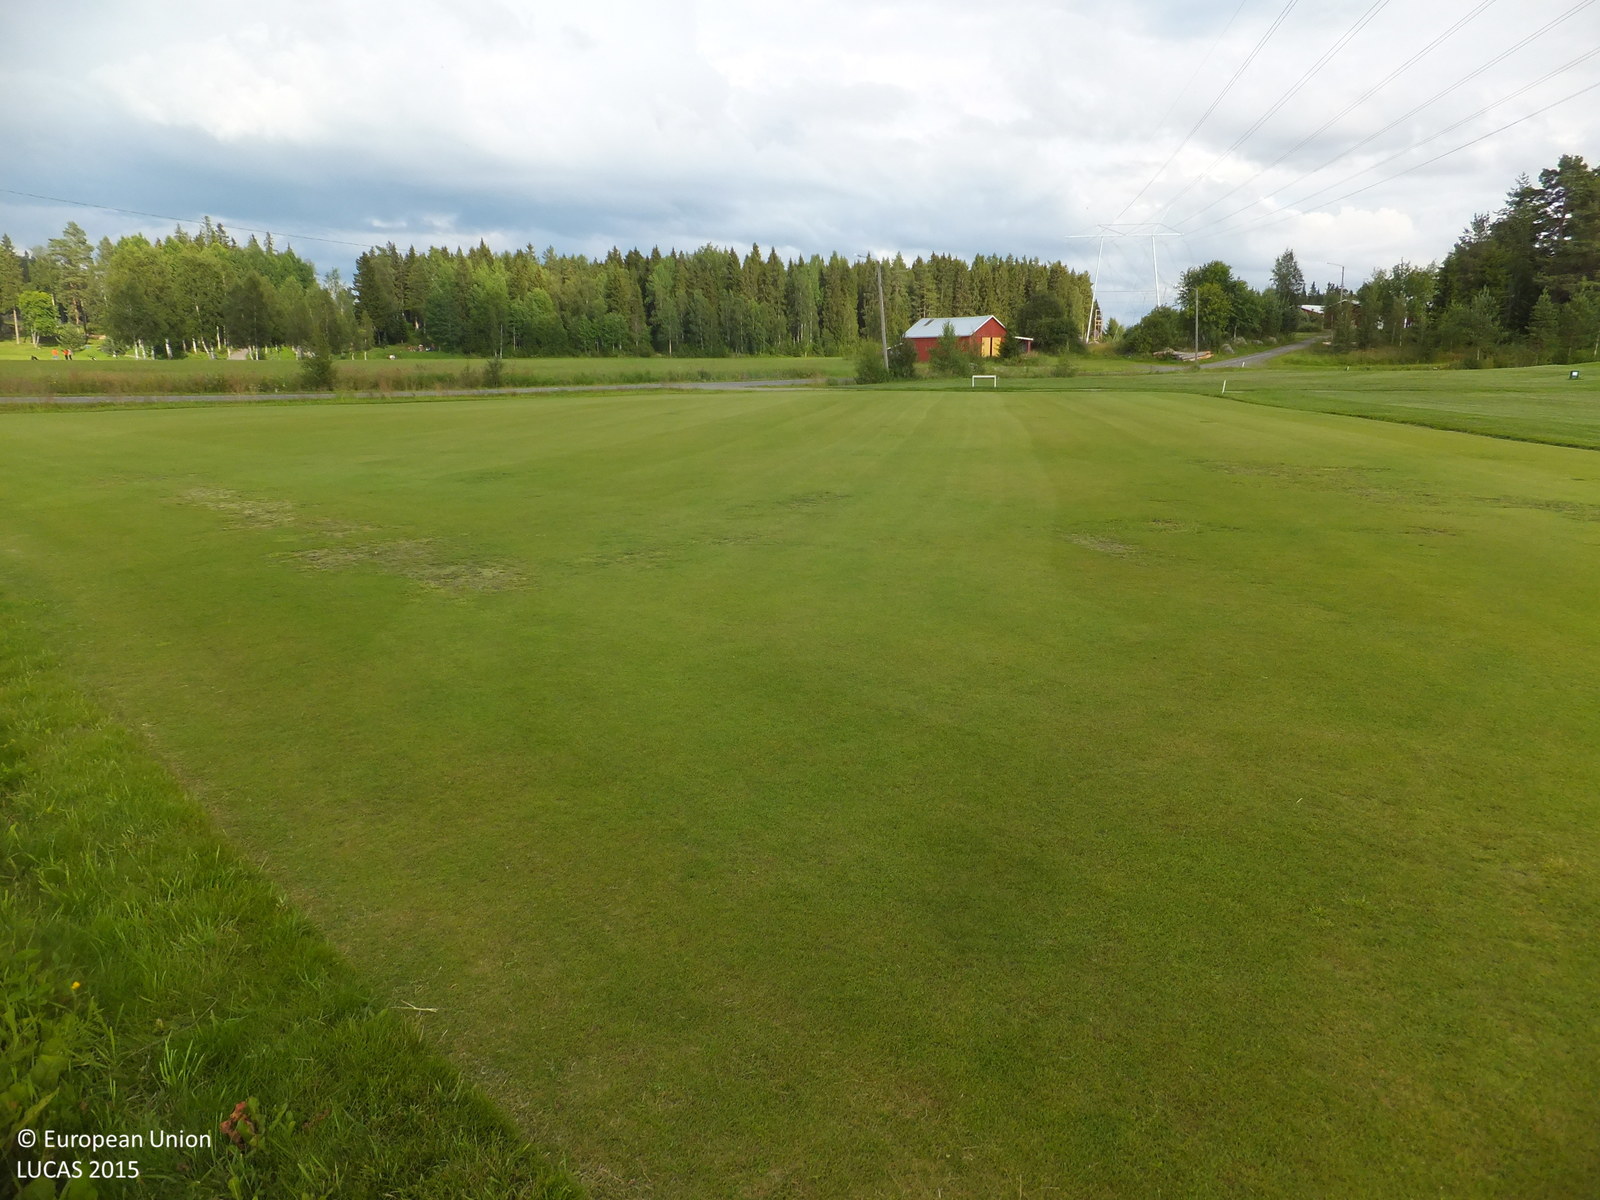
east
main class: Cropland
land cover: Barley
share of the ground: 25 - 50 %
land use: Agriculture (excluding fallow land and kitchen gardens)
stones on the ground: < 10 %
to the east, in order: Barley; Grassland without tree/shrub cover; Grass margins; Electric lines; Ditches and canals; Paved roads, cycling and walking lanes; Grass margins; Ditches and canals; Barley
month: July
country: FI
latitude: 63.0830
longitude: 21.7432
